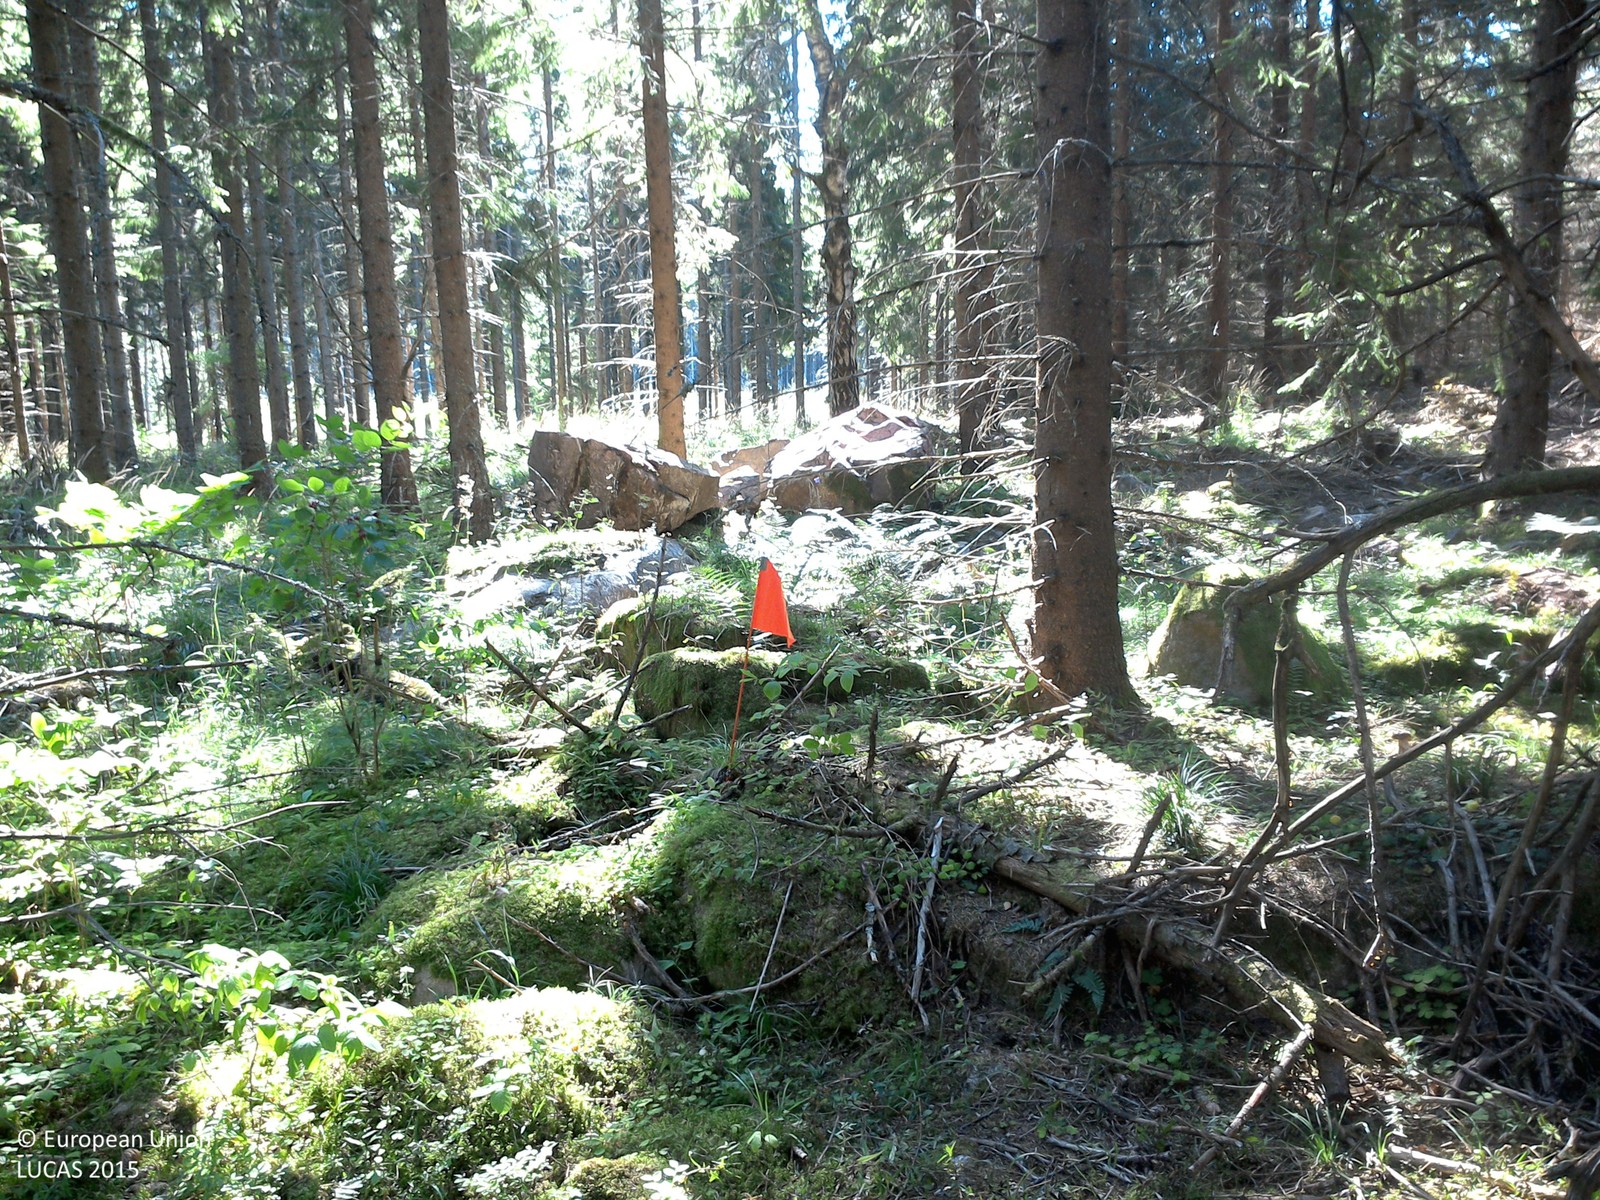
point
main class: Woodland
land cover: Spruce dominated coniferous woodland
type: boreal forest
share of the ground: 50 - 75 %
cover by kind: coniferous forest trees 70 %, herbaceous plants 20 %, lichens and mosses 10 %
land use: Forestry
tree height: > 5 m
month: August
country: SE
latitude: 58.1174
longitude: 15.2401
